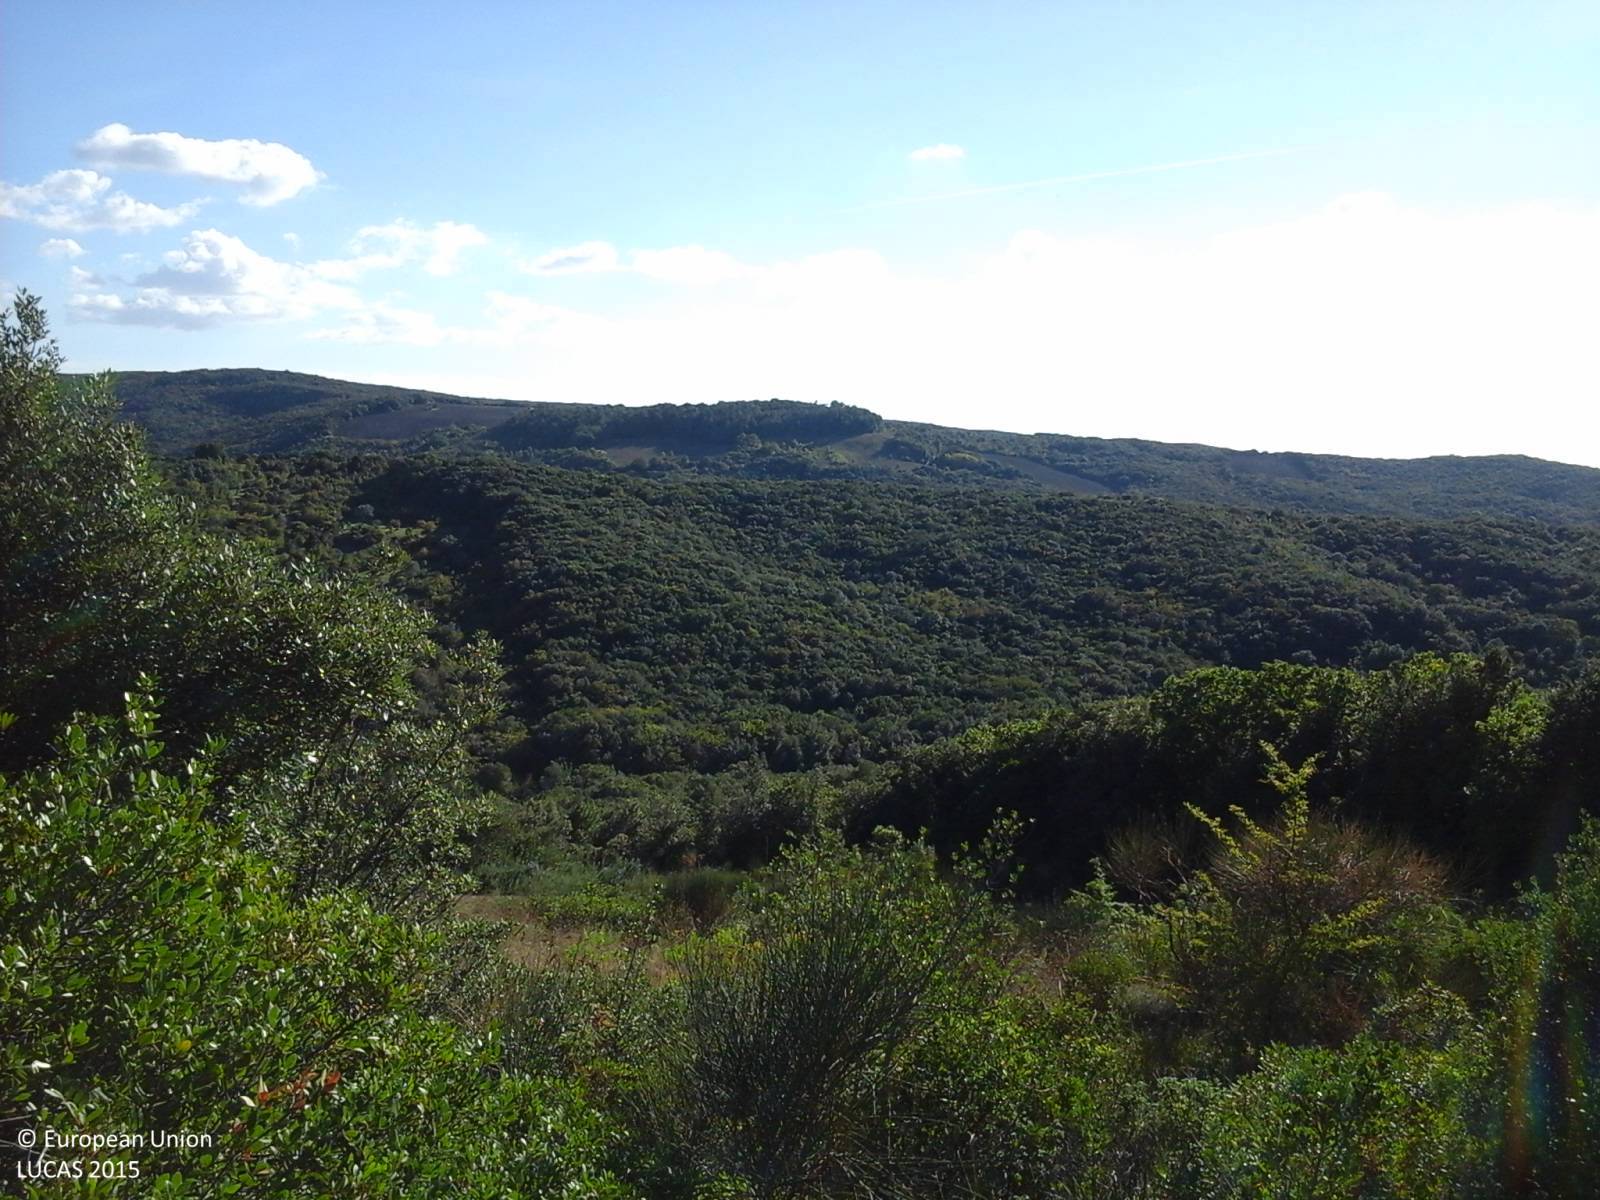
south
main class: Woodland
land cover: Broadleaved woodland
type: thermophilous deciduous forest
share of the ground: > 75 %
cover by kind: broadleaved forest trees 80 %, shrubs 20 %
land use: Forestry
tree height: > 5 m
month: October
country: IT
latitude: 43.4108
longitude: 10.5541
